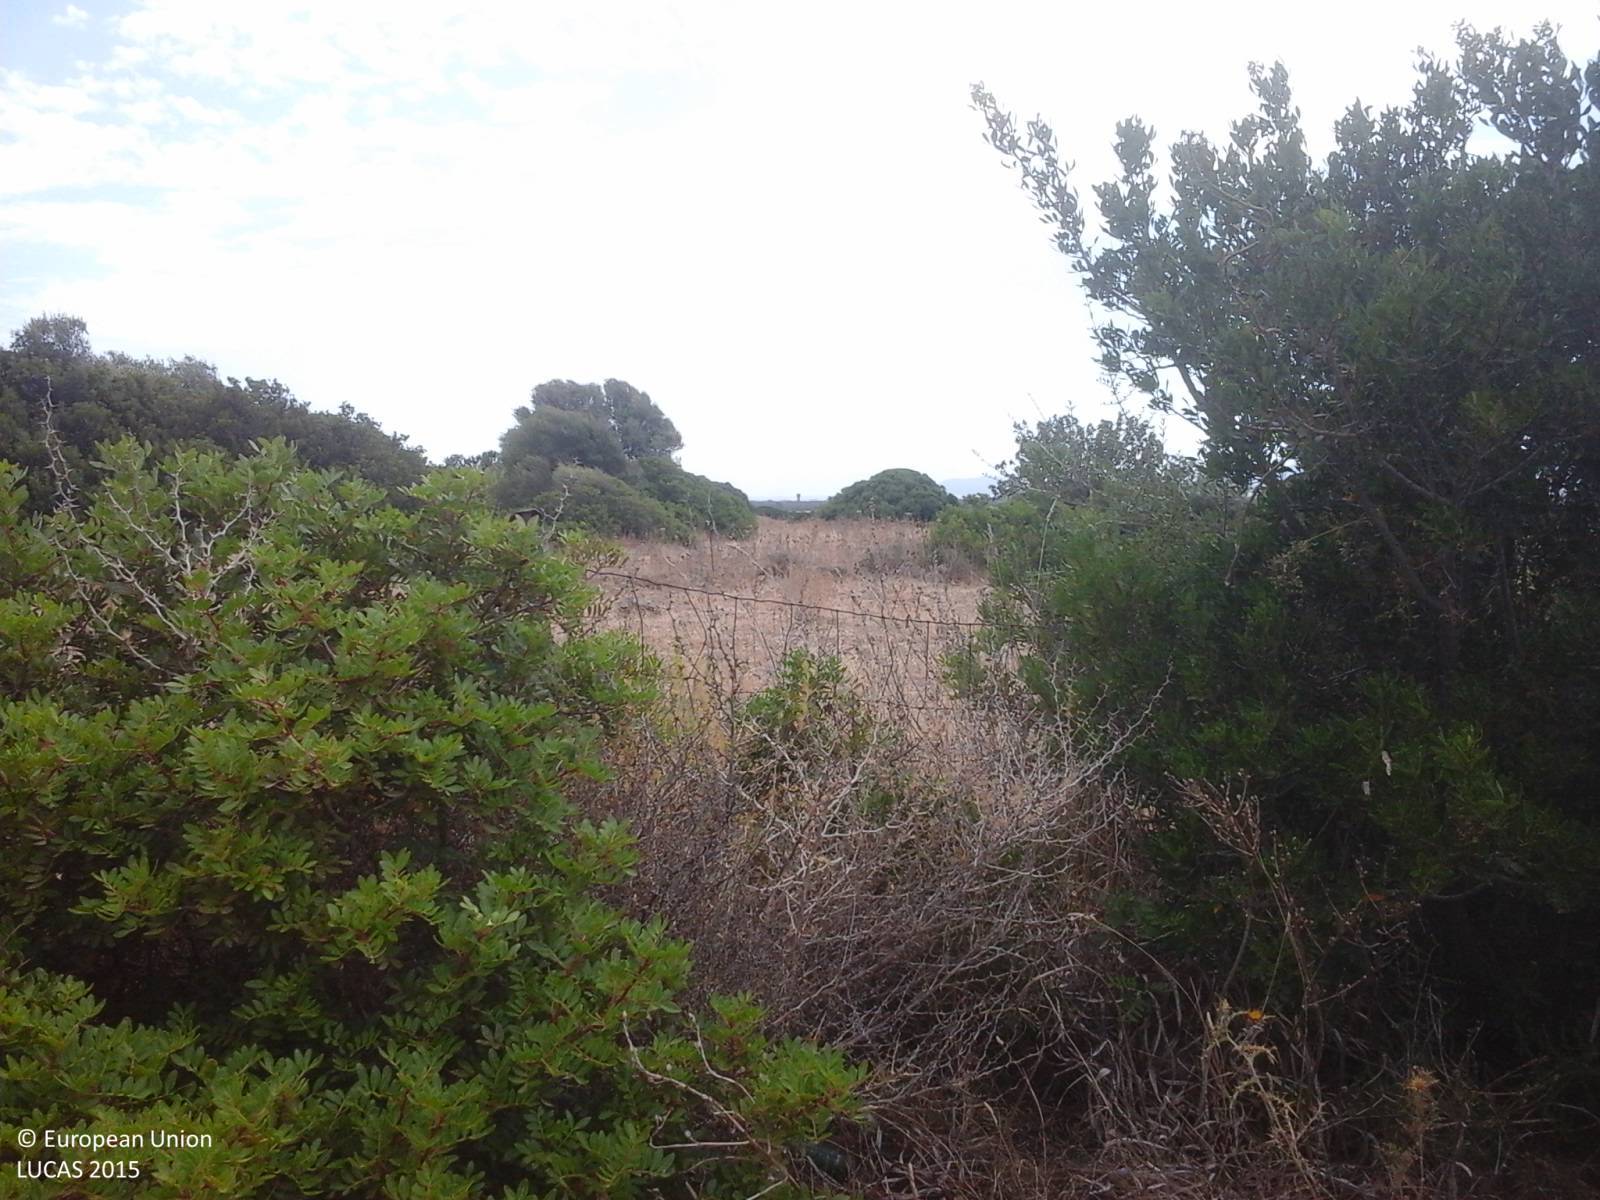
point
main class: Shrubland
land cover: Shrubland without tree cover
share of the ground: > 75 %
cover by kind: shrubs 60 %, herbaceous plants 30 %, unconsolidated bare surface 10 %
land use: Agriculture (excluding fallow land and kitchen gardens)
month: July
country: IT
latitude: 39.1155
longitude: 8.5633
